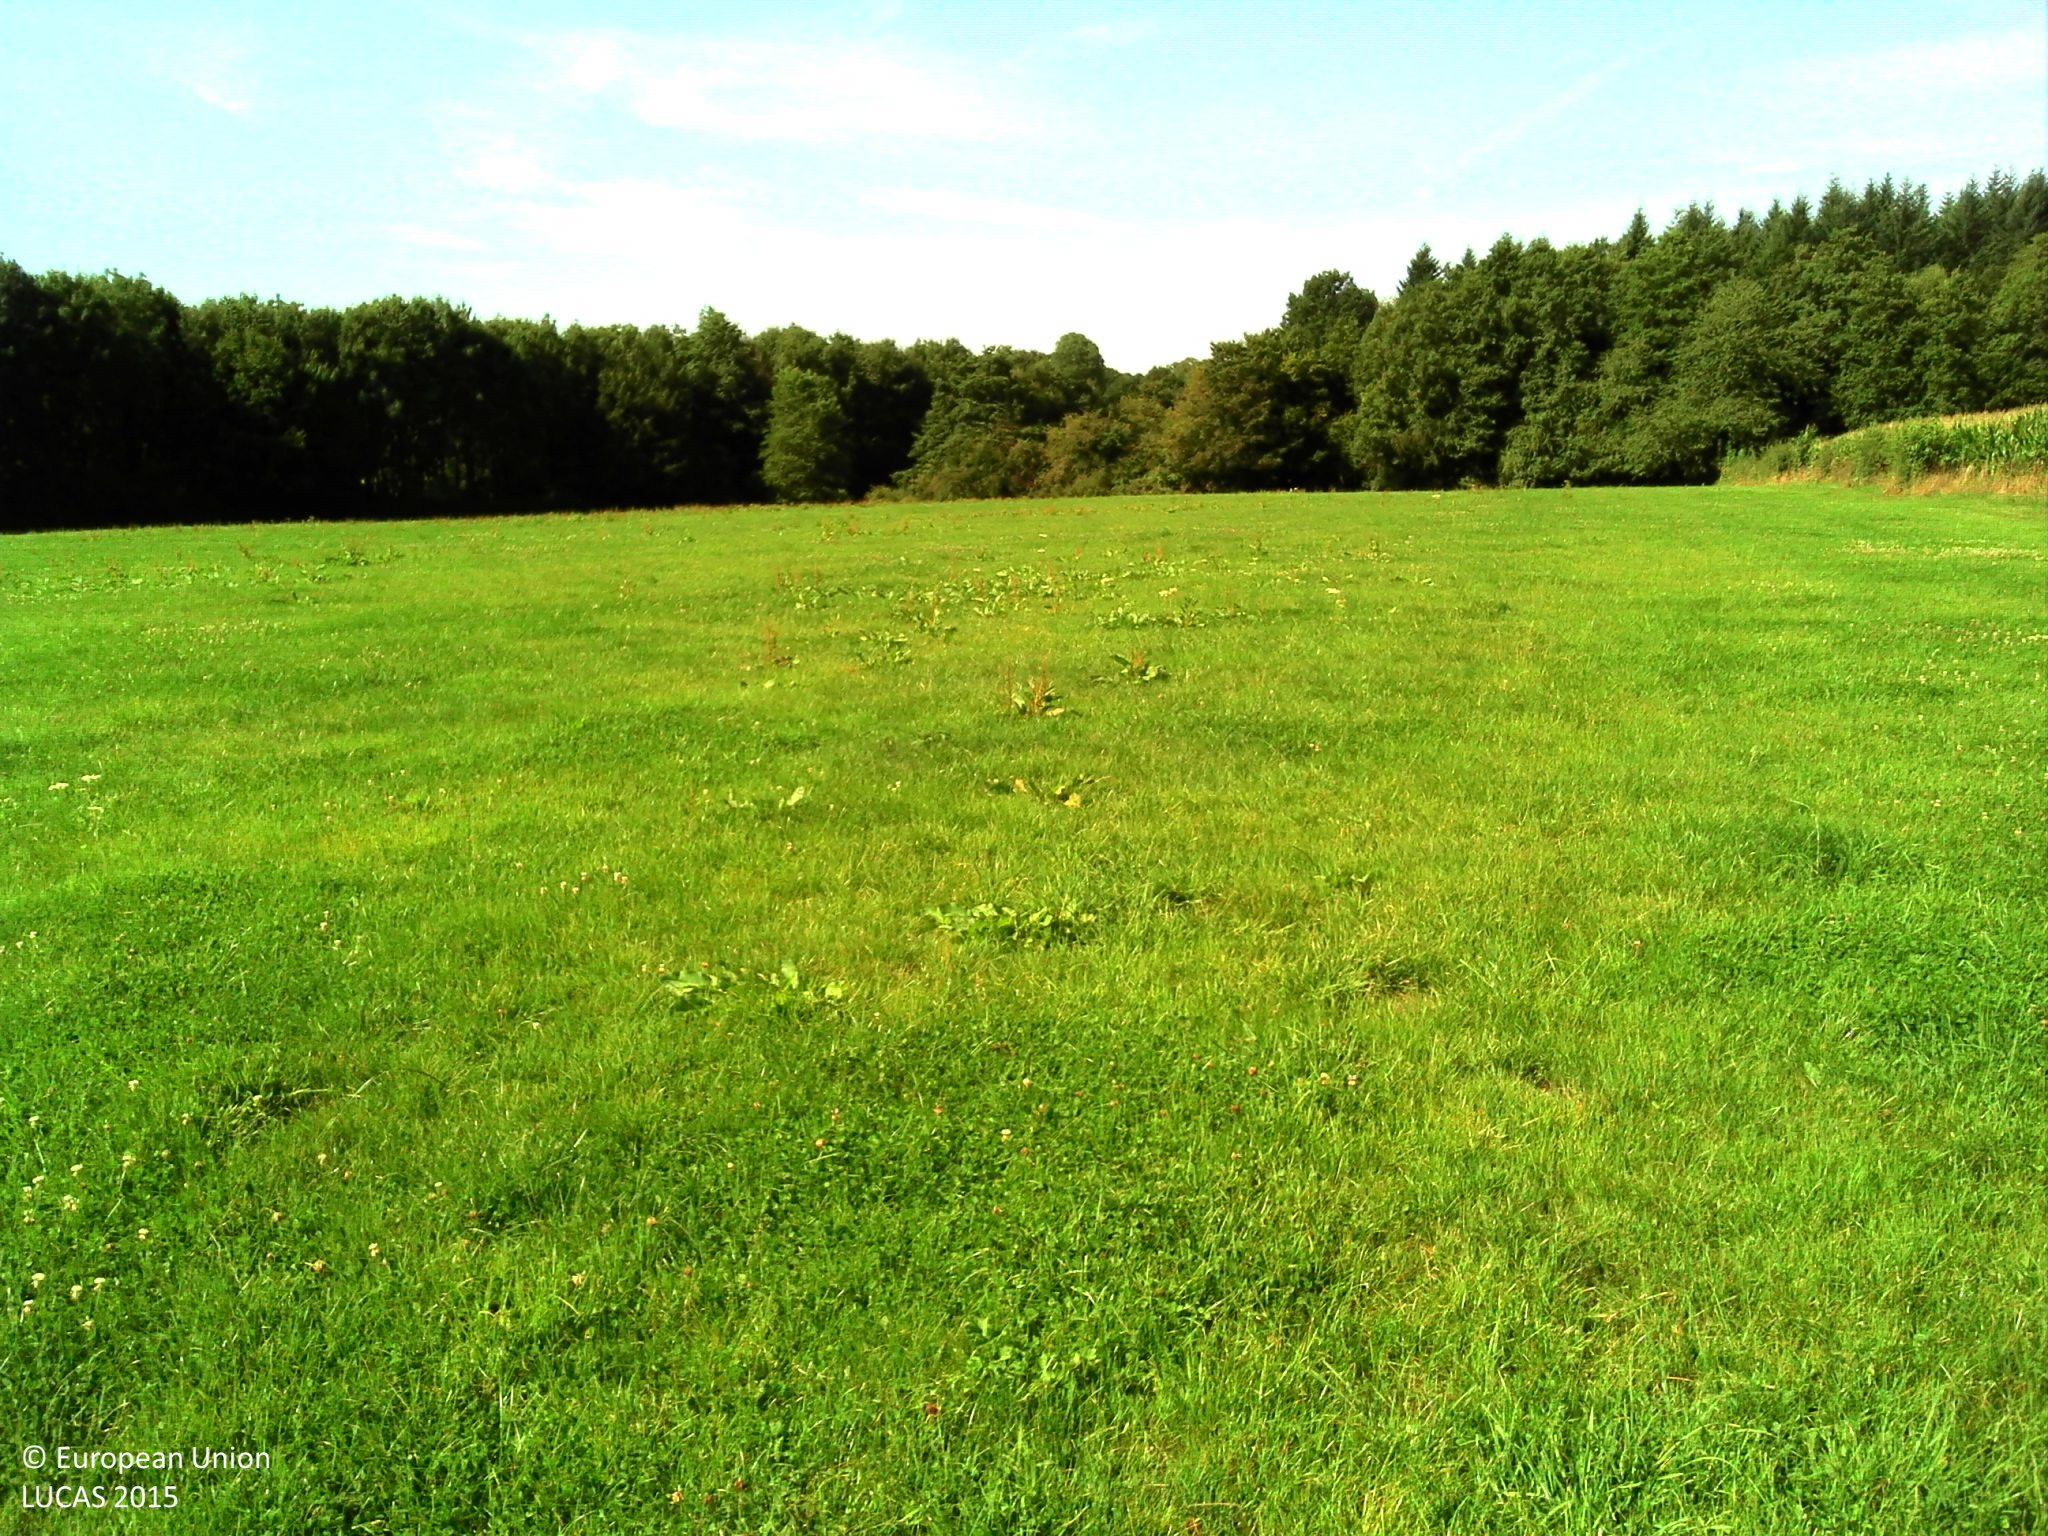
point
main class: Grassland
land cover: Grassland without tree/shrub cover
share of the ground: > 75 %
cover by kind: herbaceous plants 100 %
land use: Agriculture (excluding fallow land and kitchen gardens)
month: August
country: FR
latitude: 50.1534
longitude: 4.0182
